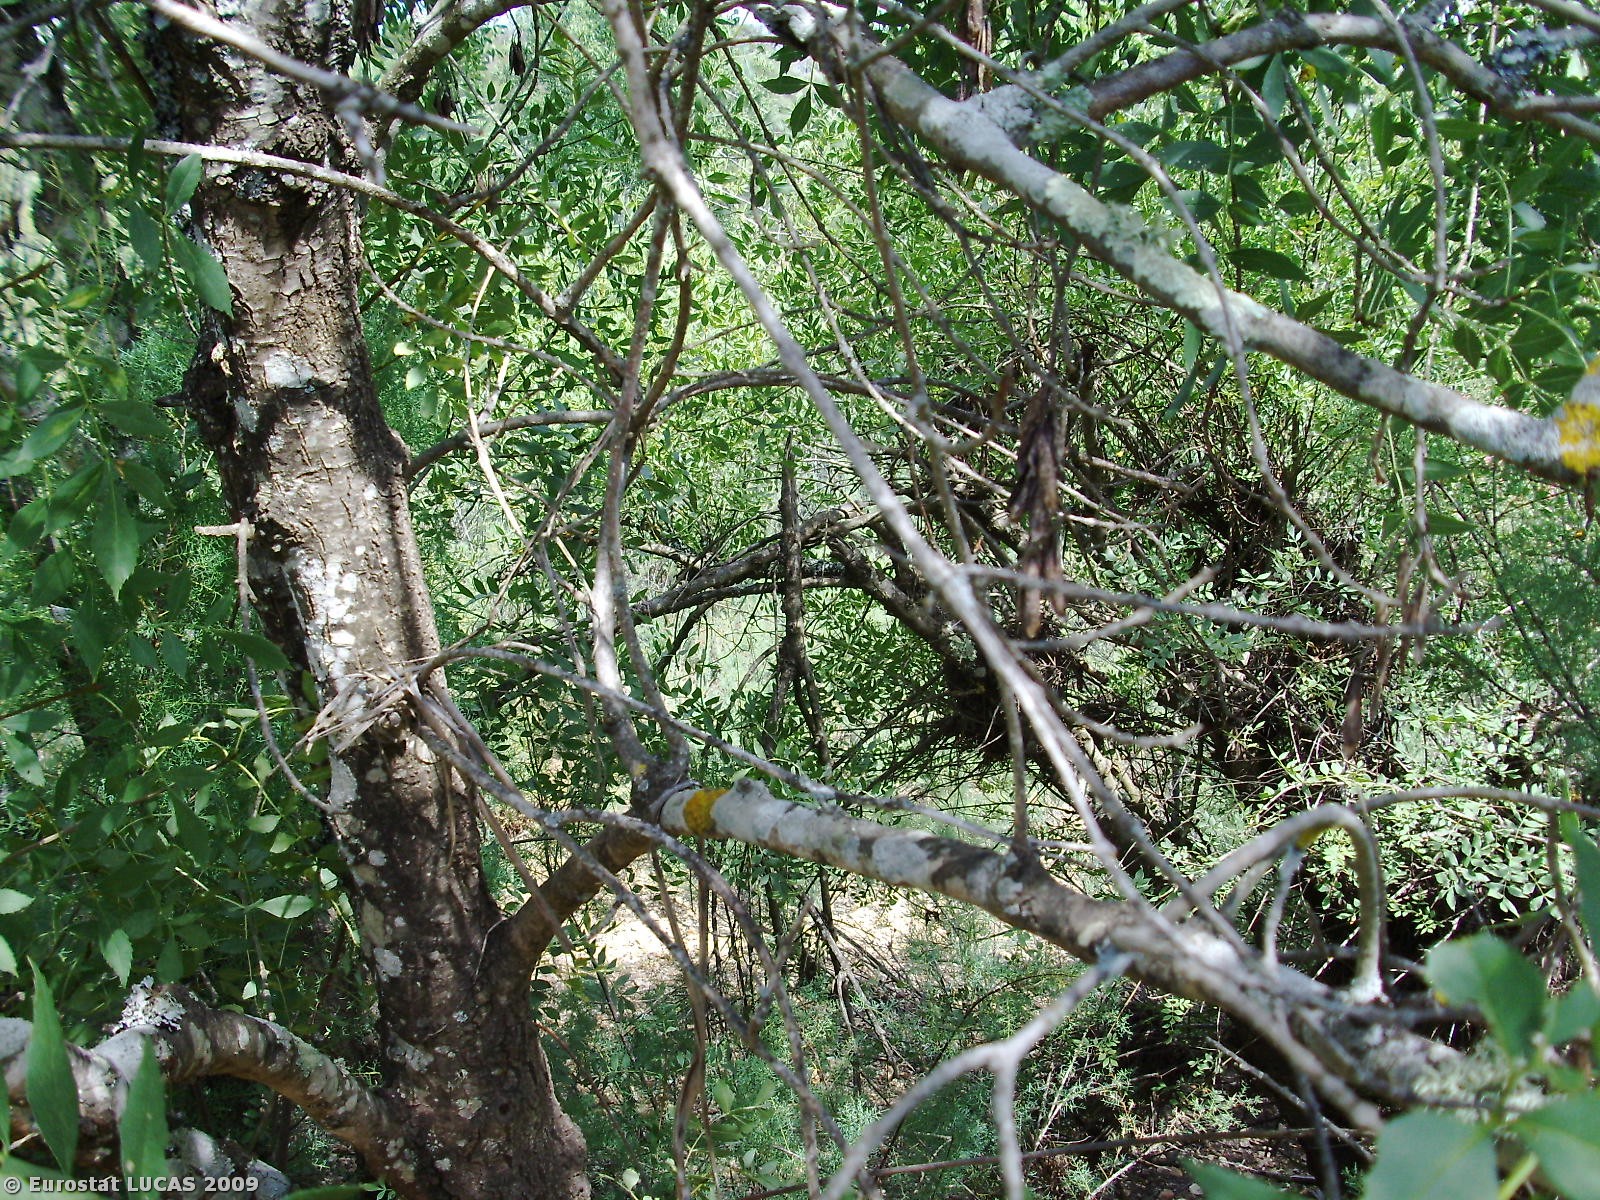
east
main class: Woodland
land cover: Mixed woodland
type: floodplain forest
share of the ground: > 75 %
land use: Unused
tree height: > 5 m
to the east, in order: Mixed woodland; Rivers and streams; Mixed woodland; Broadleaved woodland
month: June
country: PT
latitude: 38.0342
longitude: -8.3722
